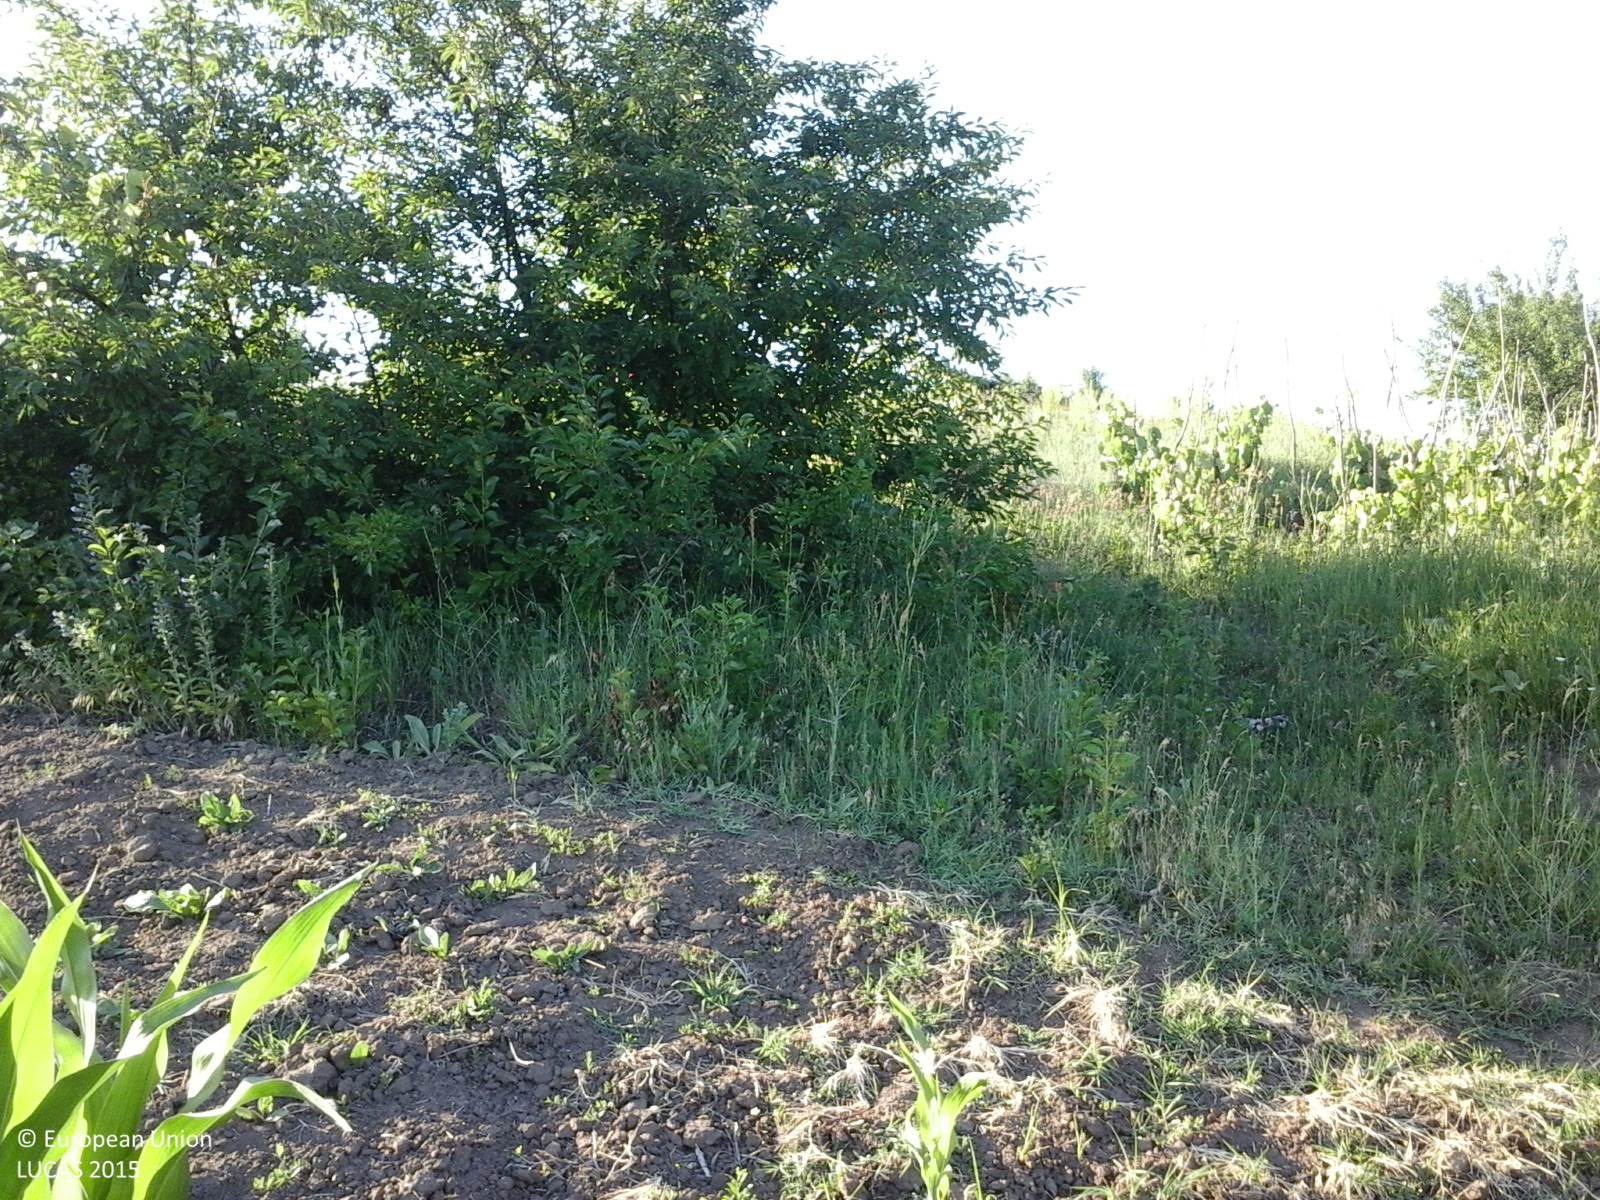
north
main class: Cropland
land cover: Maize
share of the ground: > 75 %
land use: Agriculture (excluding fallow land and kitchen gardens)
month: June
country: RO
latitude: 46.9394
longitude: 27.6017
